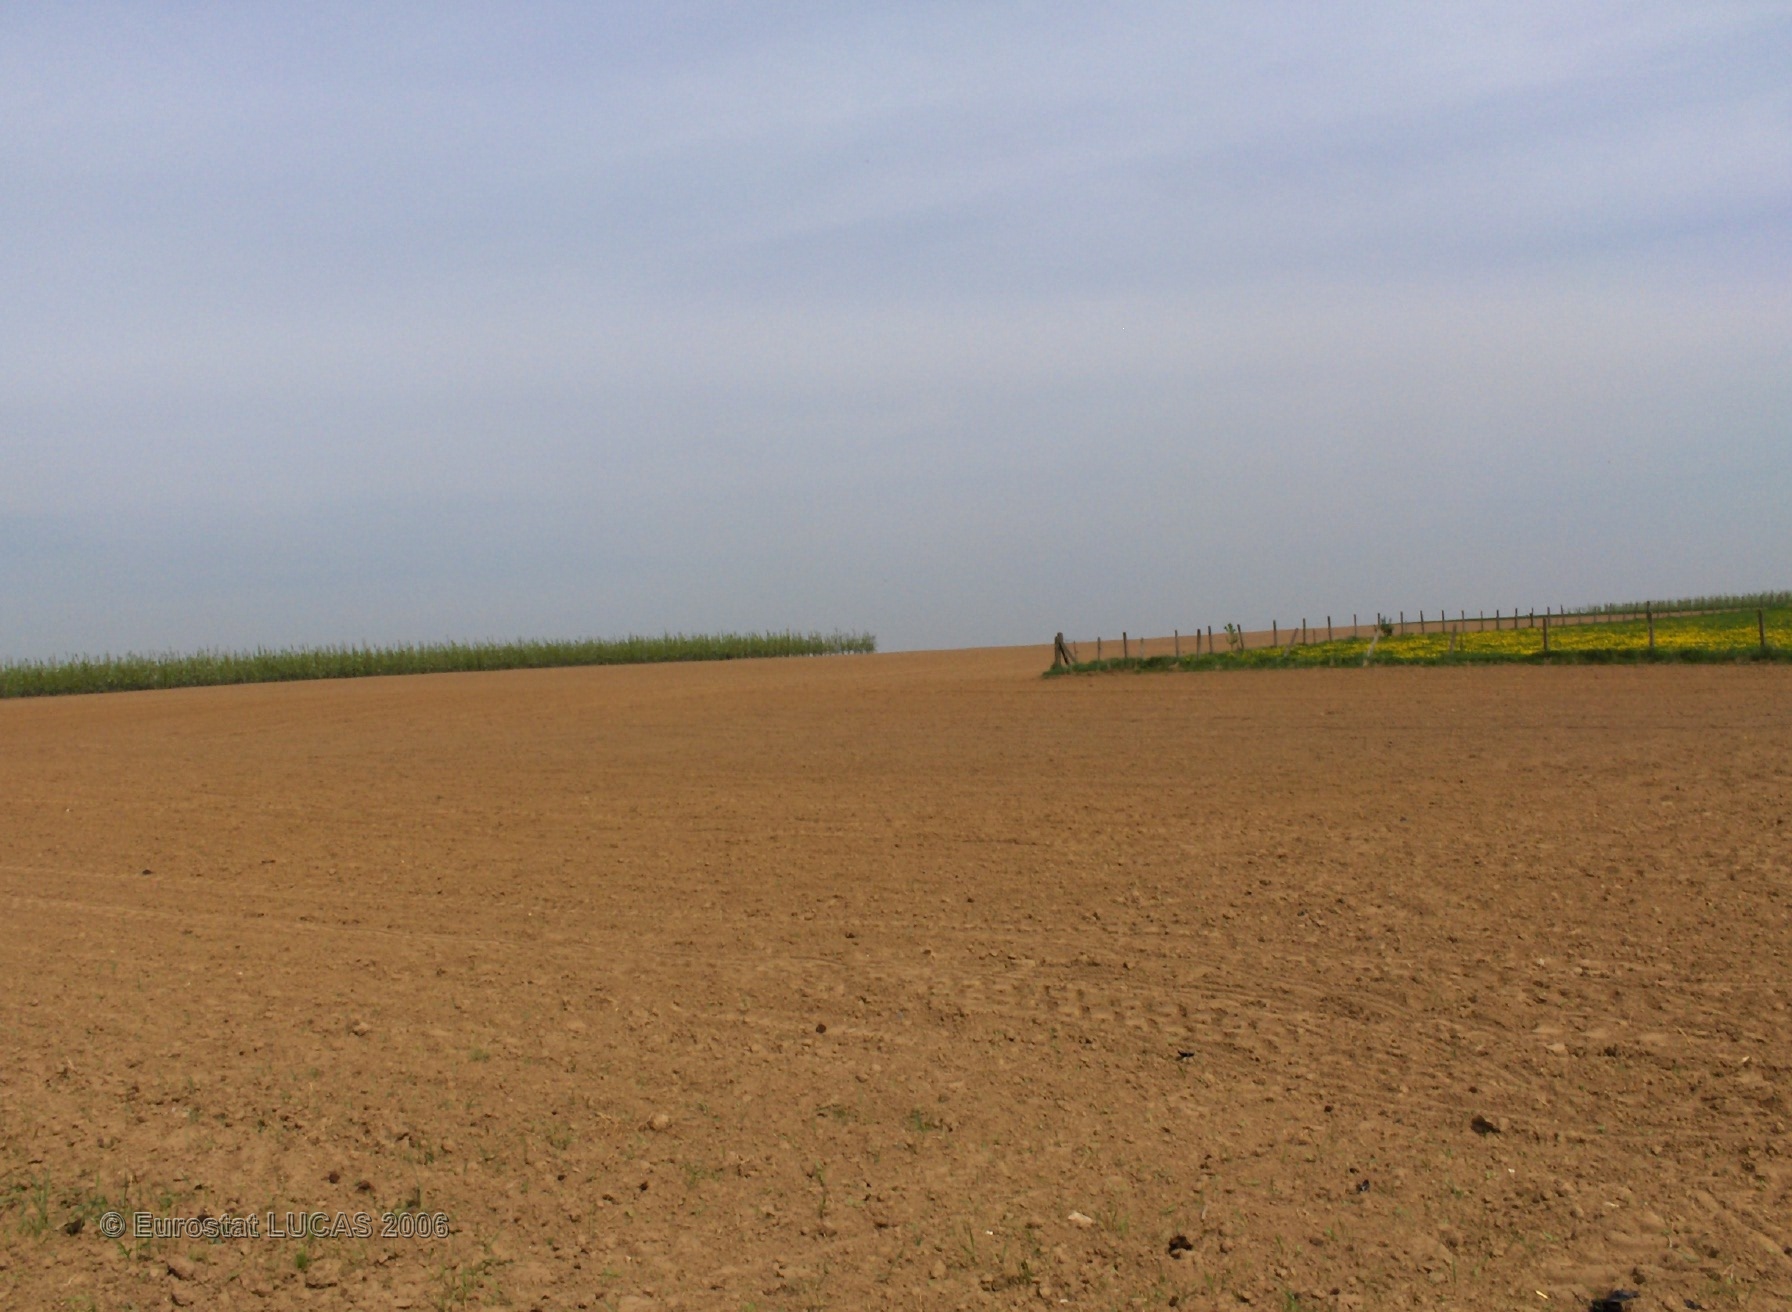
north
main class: Cropland
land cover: Maize
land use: Agriculture (excluding fallow land and kitchen gardens)
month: May
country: BE
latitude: 50.7326
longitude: 5.2229
